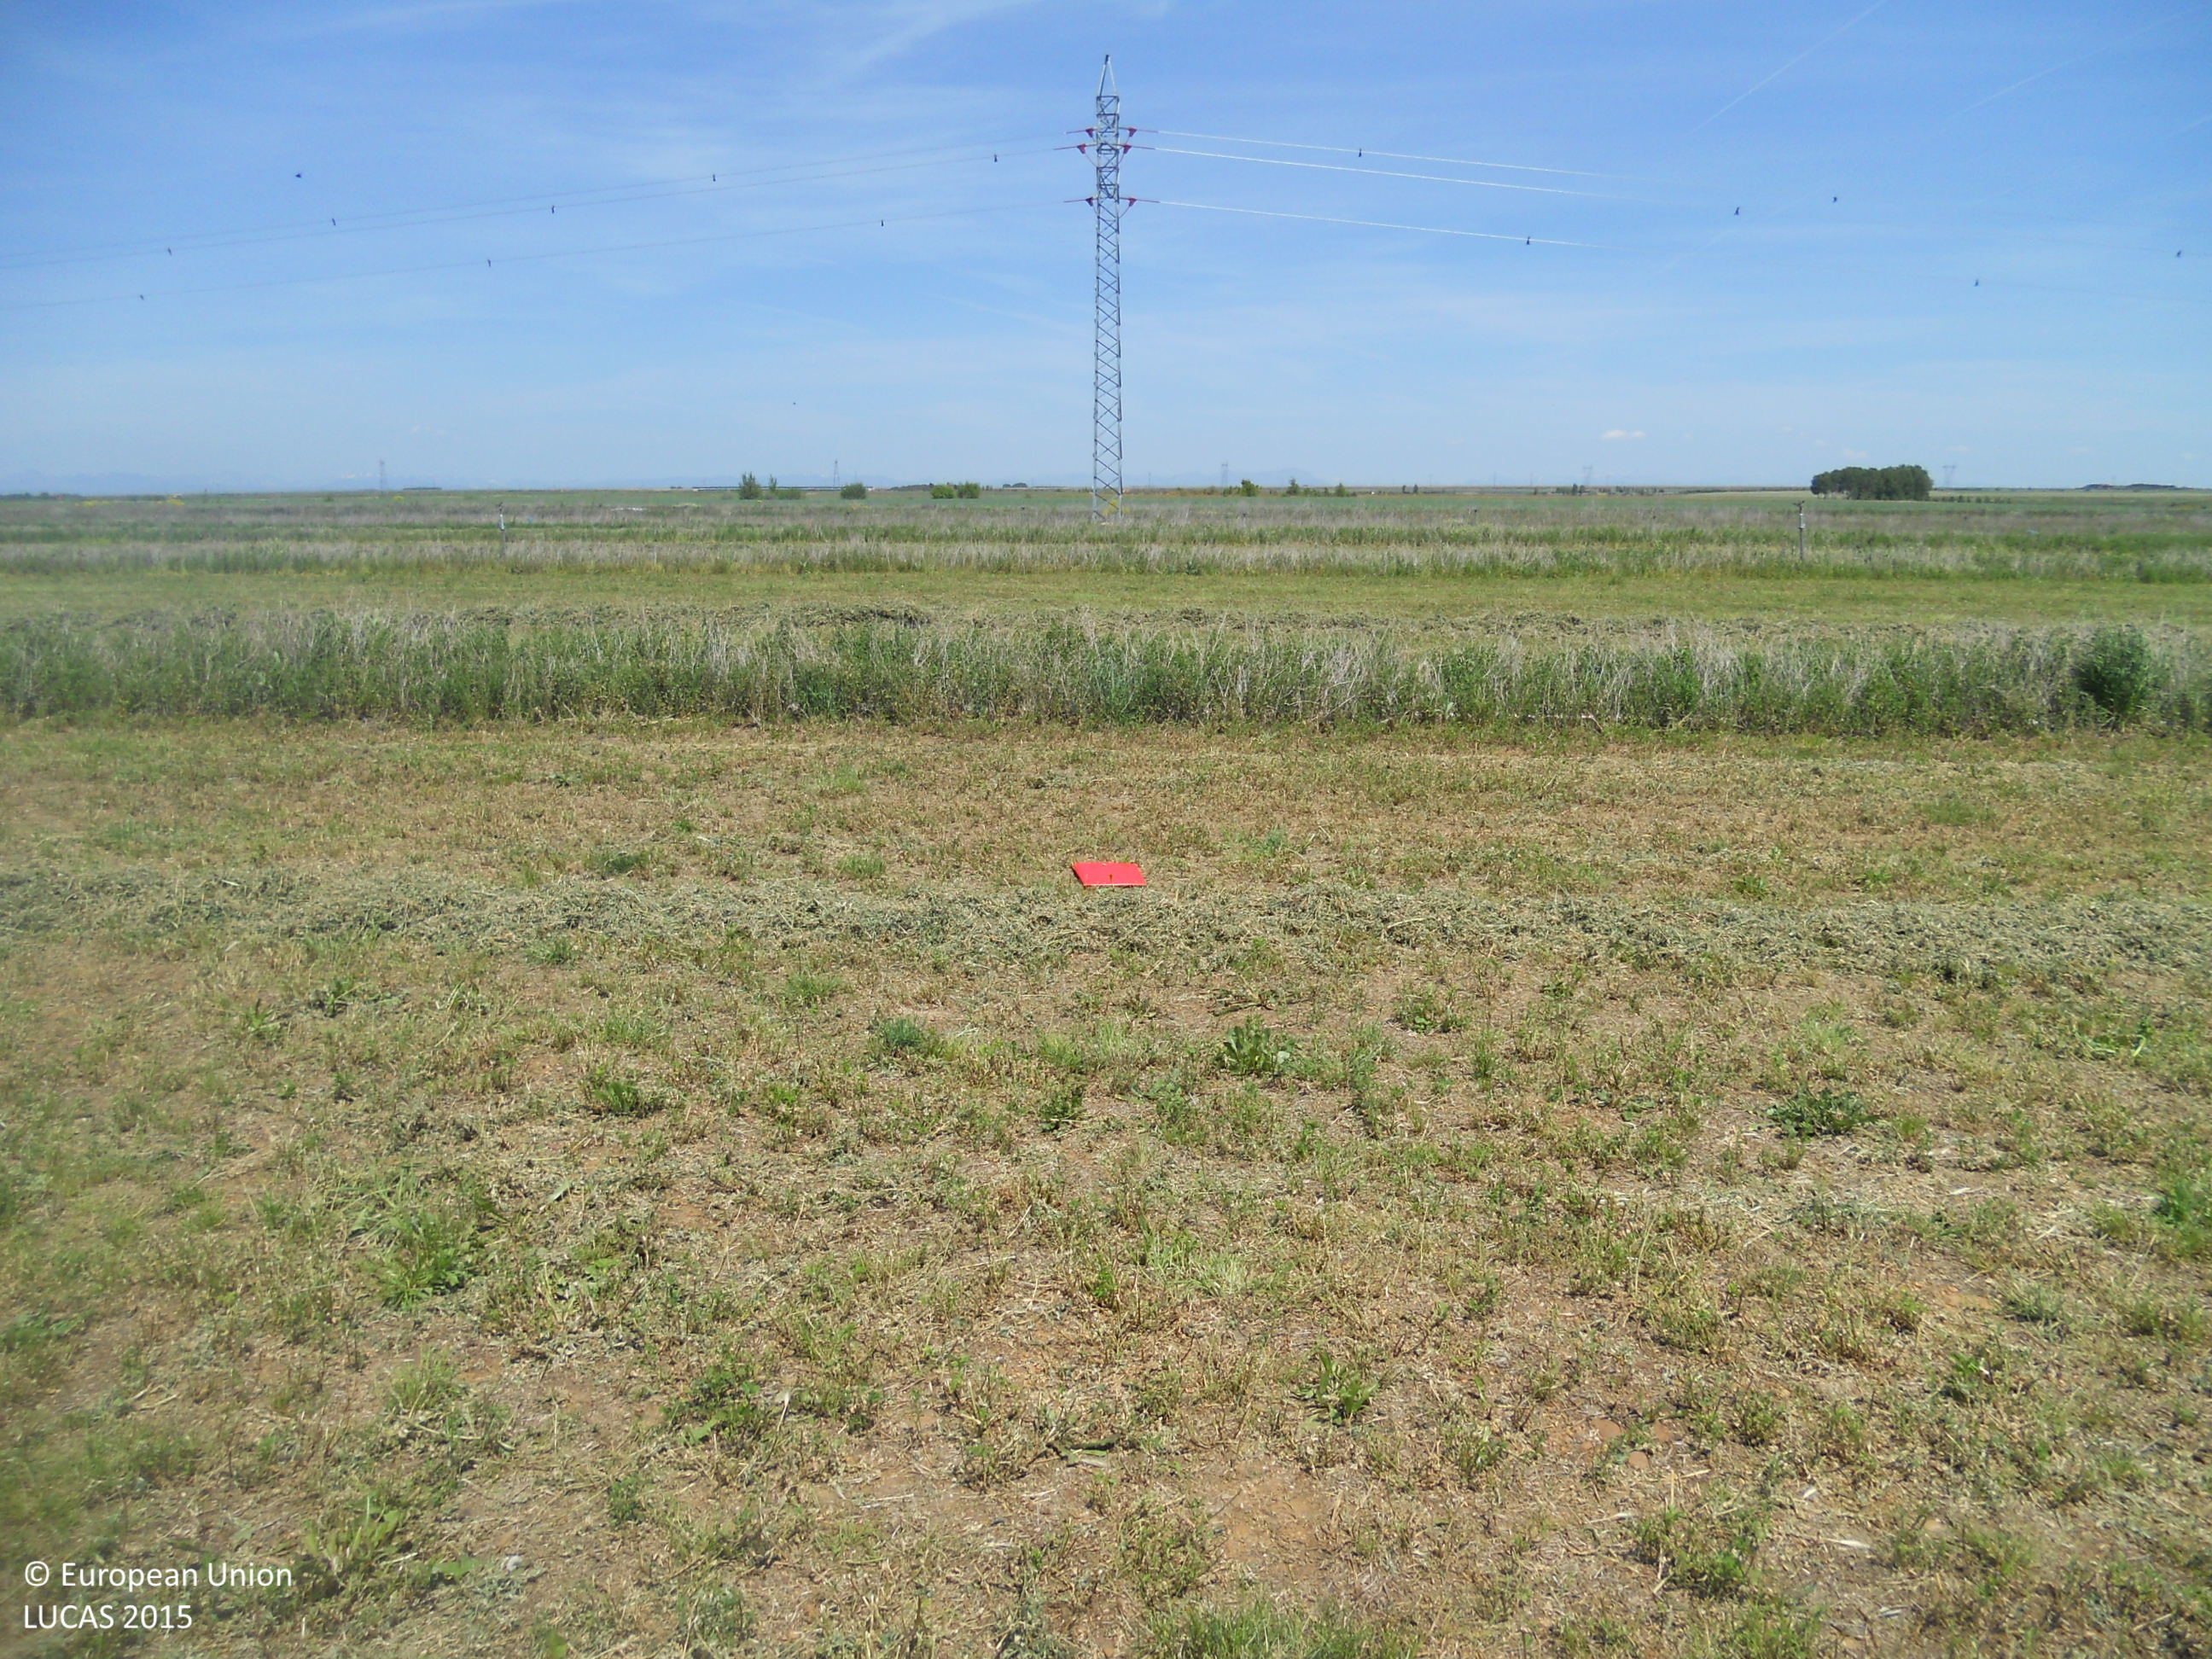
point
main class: Cropland
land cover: Lucerne
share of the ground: > 75 %
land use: Agriculture (excluding fallow land and kitchen gardens)
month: May
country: ES
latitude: 42.4028
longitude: -5.2883
